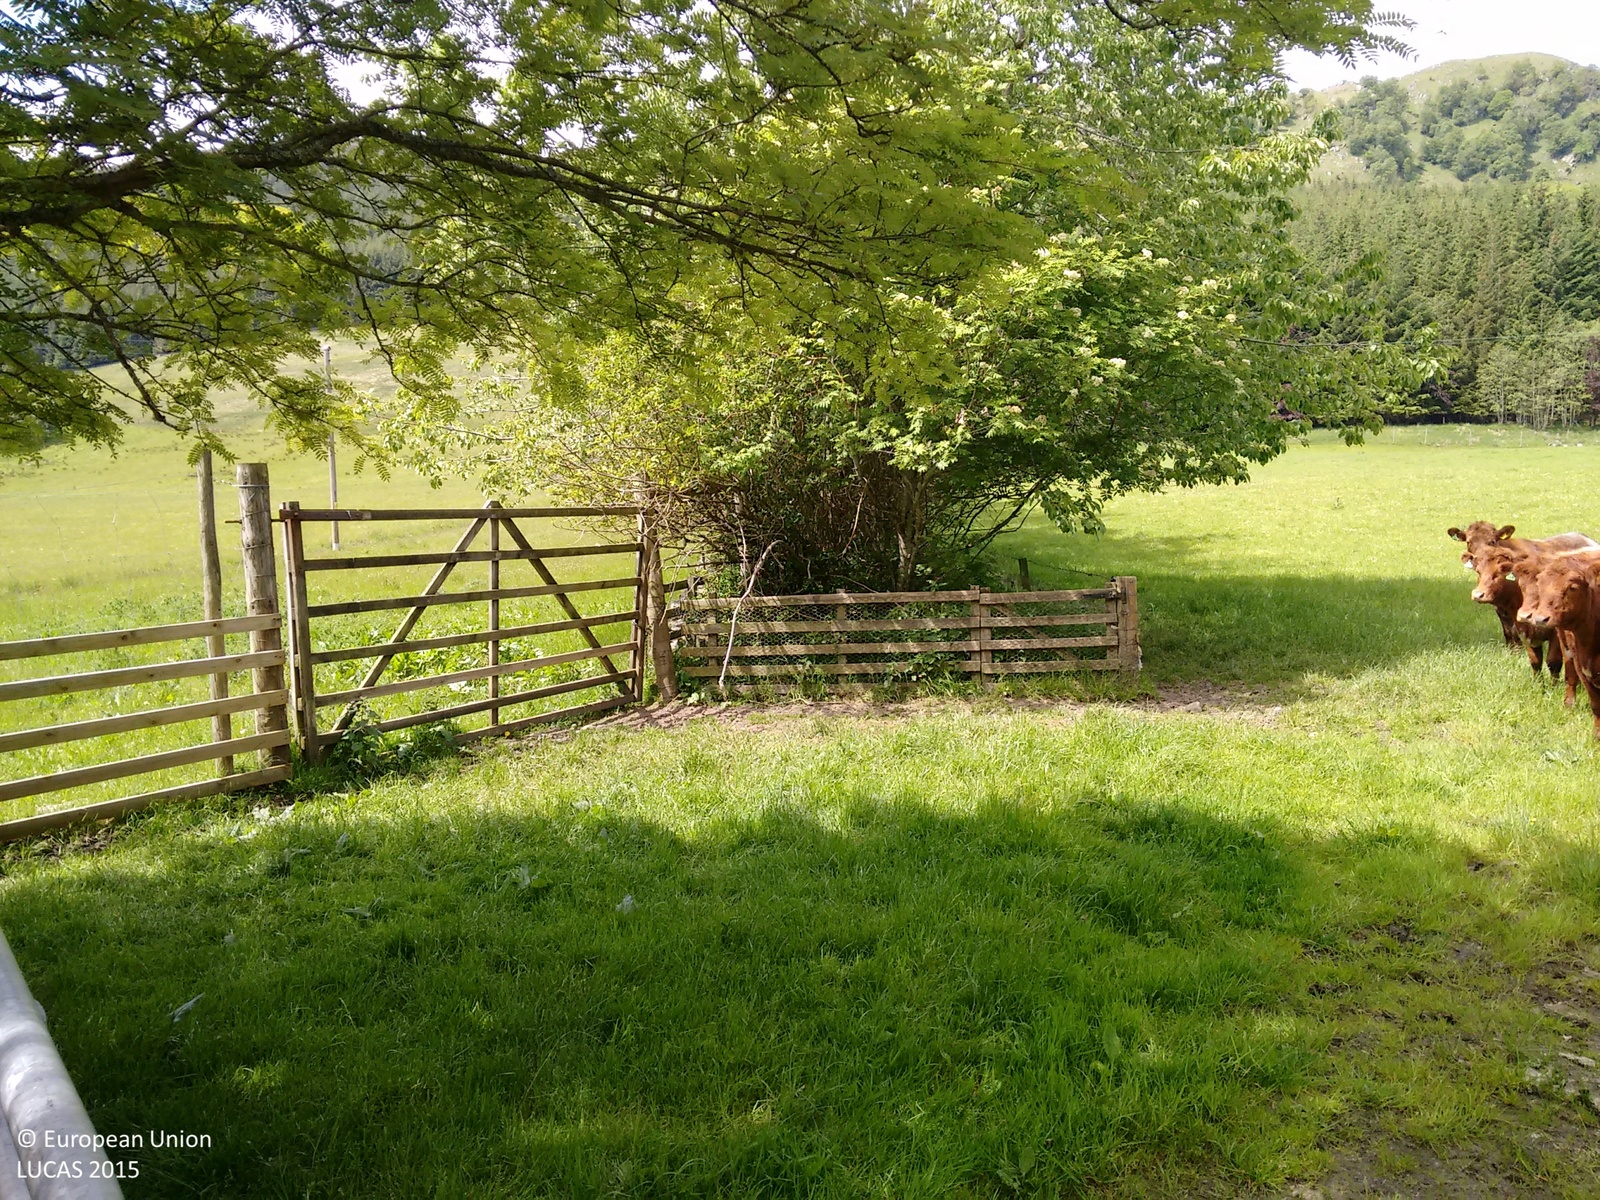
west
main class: Grassland
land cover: Grassland without tree/shrub cover
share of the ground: > 75 %
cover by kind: herbaceous plants 100 %
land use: Agriculture (excluding fallow land and kitchen gardens)
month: June
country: GB
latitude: 56.5951
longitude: -4.0761
